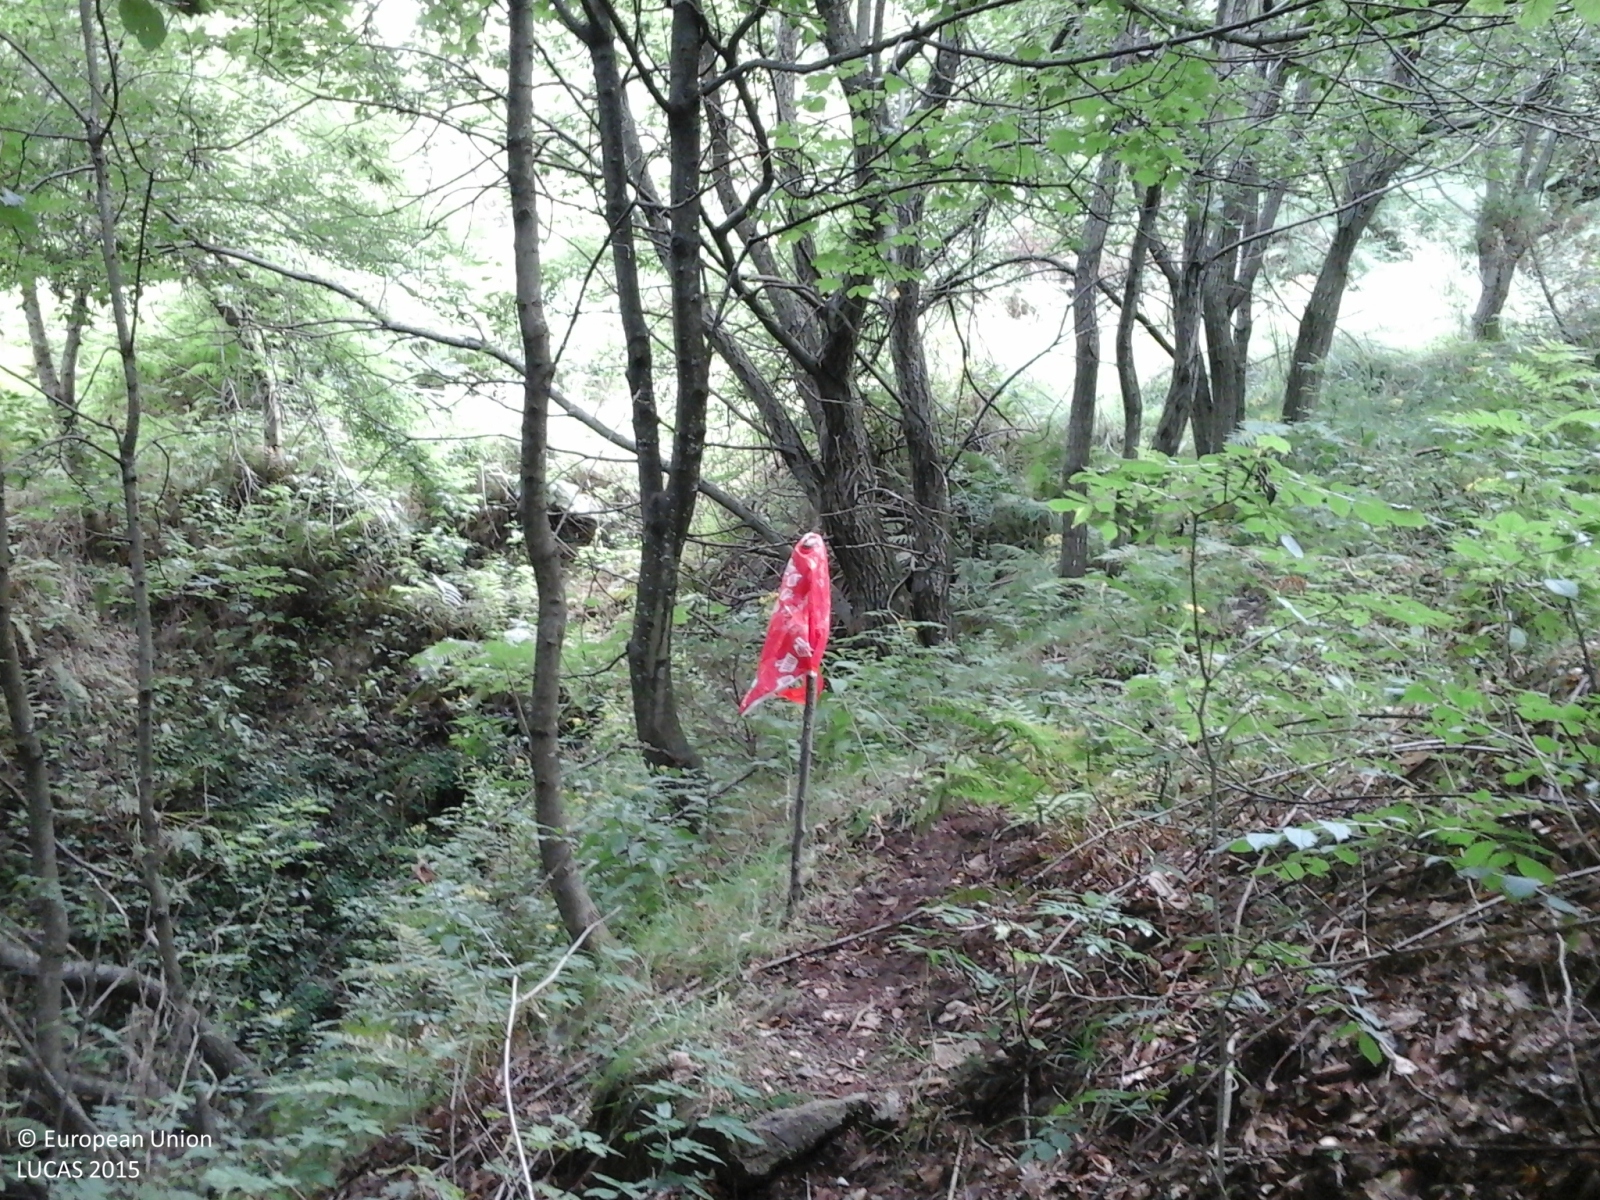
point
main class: Woodland
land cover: Broadleaved woodland
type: mountainous beech forest
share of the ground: > 75 %
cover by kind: broadleaved forest trees 80 %, coniferous forest trees 10 %, herbaceous plants 10 %
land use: Forestry
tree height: > 5 m
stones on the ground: < 10 %
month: August
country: IT
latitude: 46.0773
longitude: 9.1091
